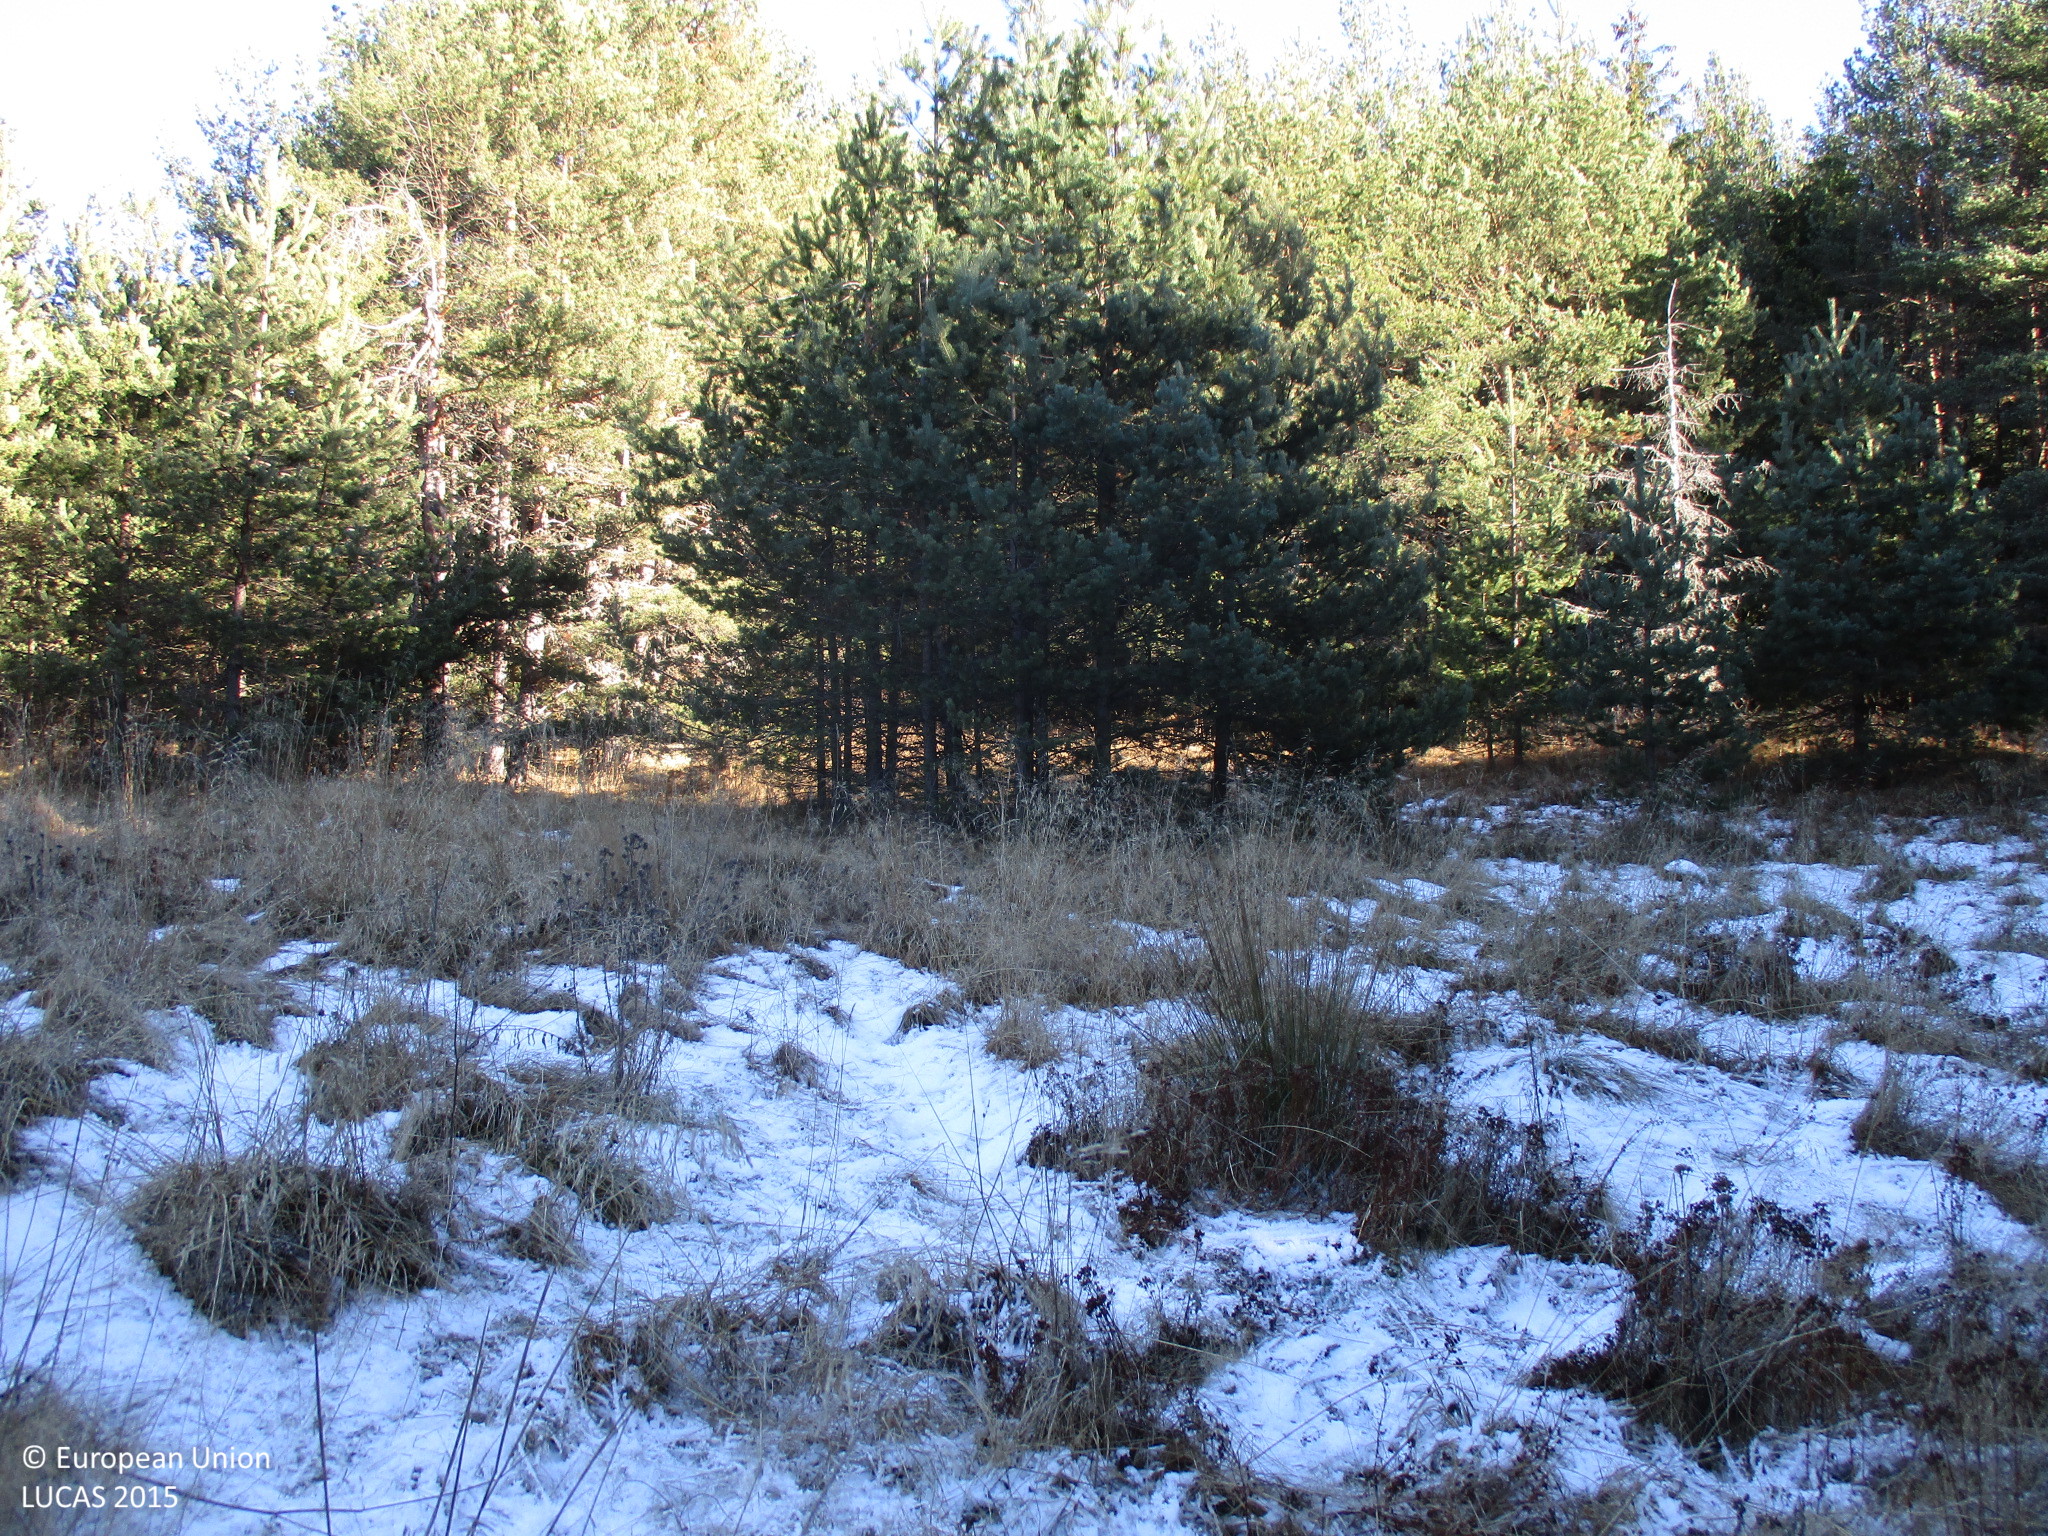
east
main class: Woodland
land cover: Spruce dominated coniferous woodland
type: hemiboreal forest and nemoral coniferous forest and mixed broadleaved-coniferous forest
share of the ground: 25 - 50 %
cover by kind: herbaceous plants 75 %, coniferous forest trees 25 %
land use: Forestry
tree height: > 5 m
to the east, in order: Spruce dominated coniferous woodland; Grassland with sparse tree/shrub cover; Tracks; Spruce dominated coniferous woodland
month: December
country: BG
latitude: 41.9337
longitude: 24.6277
